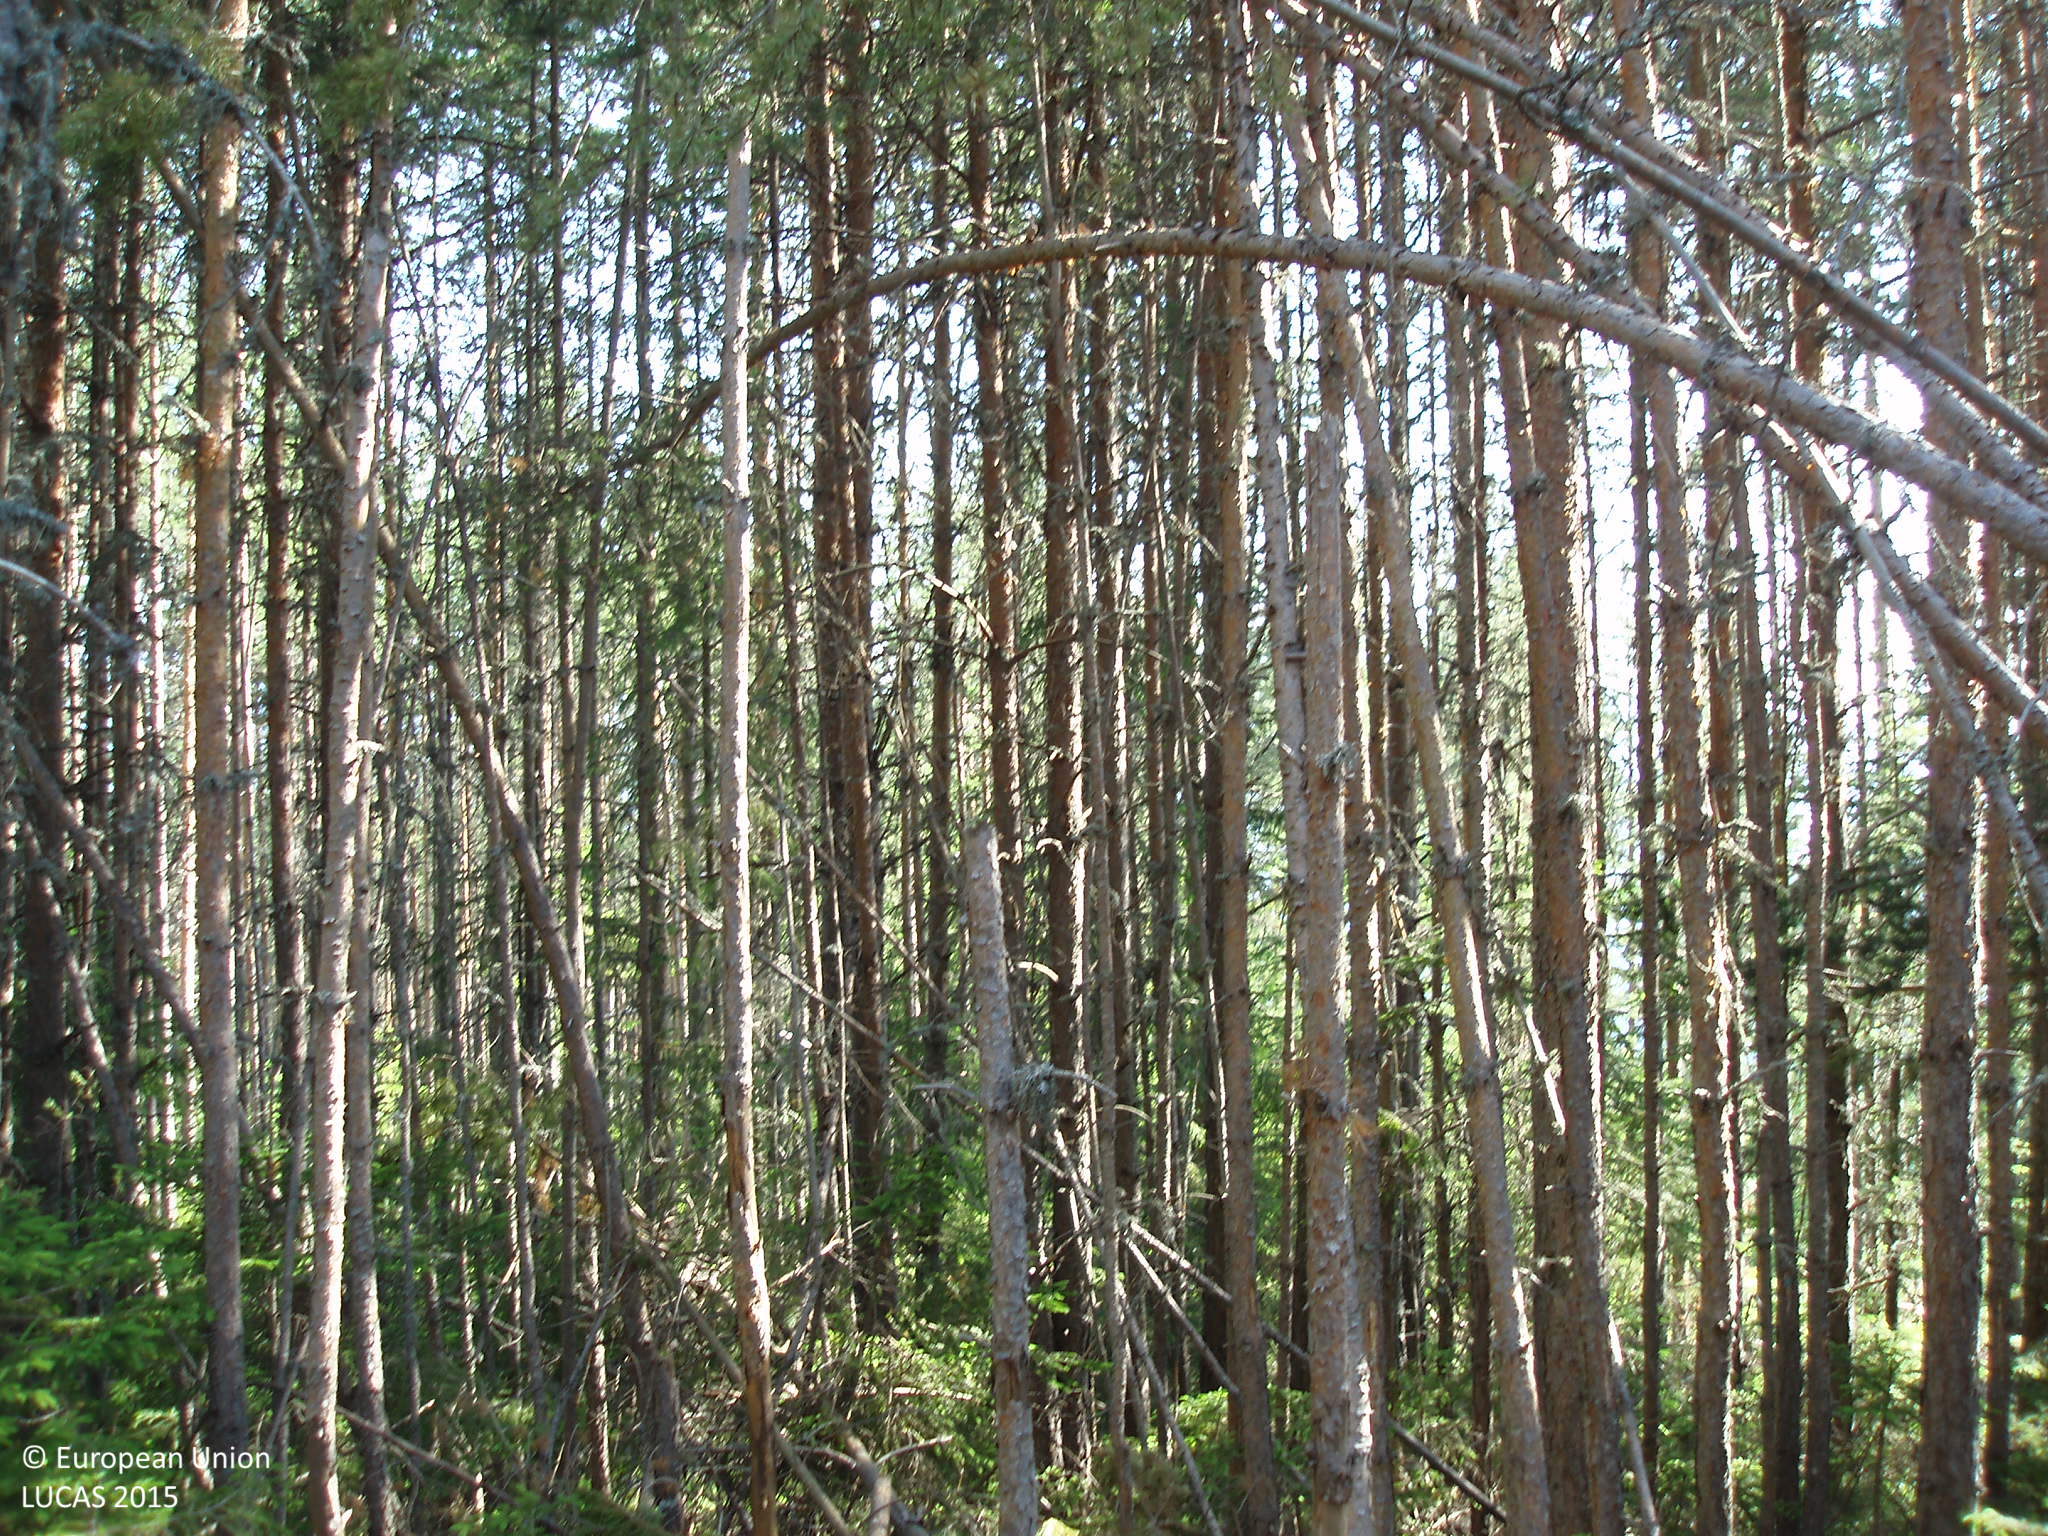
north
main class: Woodland
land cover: Pine dominated coniferous woodland
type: hemiboreal forest and nemoral coniferous forest and mixed broadleaved-coniferous forest
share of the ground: > 75 %
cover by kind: coniferous forest trees 100 %
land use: Forestry
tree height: > 5 m
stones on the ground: < 10 %
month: July
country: BG
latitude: 41.9749
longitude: 23.8280
